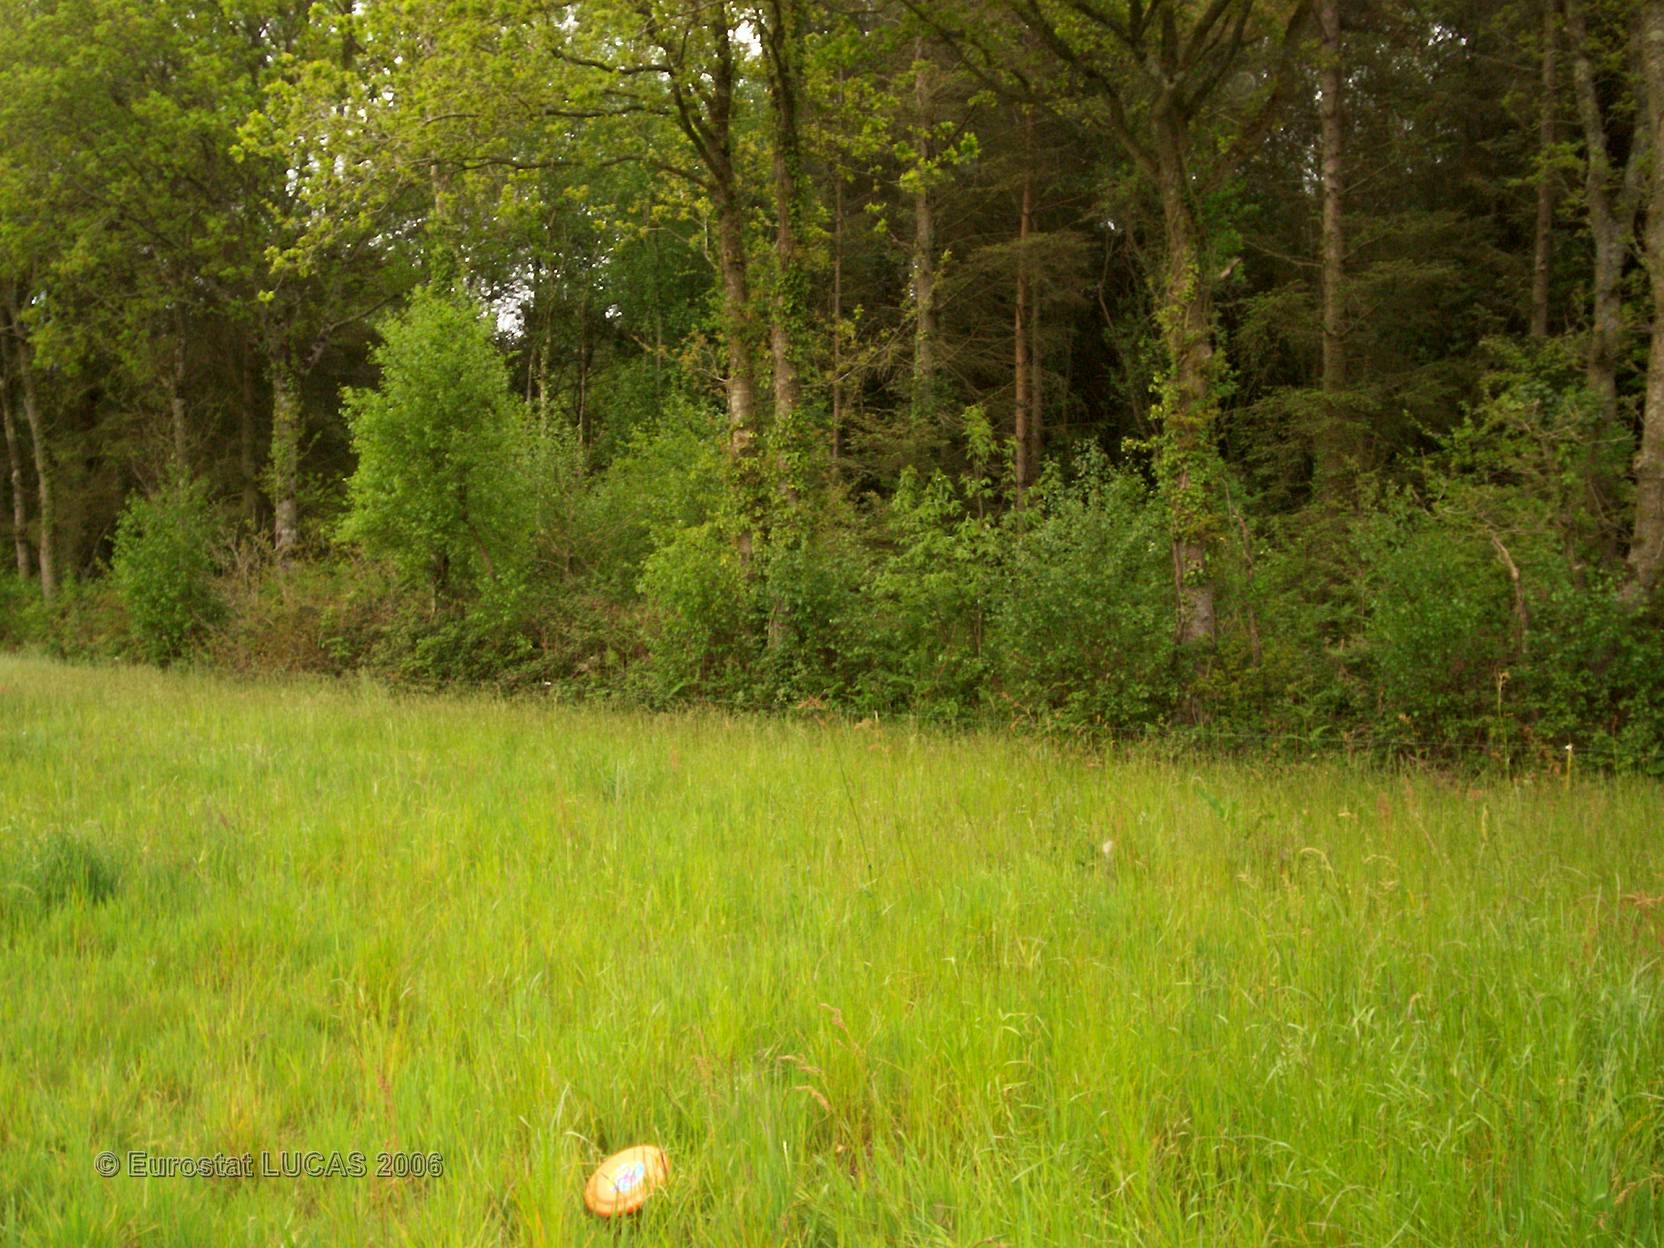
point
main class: Grassland
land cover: Grassland without tree/shrub cover
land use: Agriculture (excluding fallow land and kitchen gardens)
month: May
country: FR
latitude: 48.6630
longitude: -3.8123
